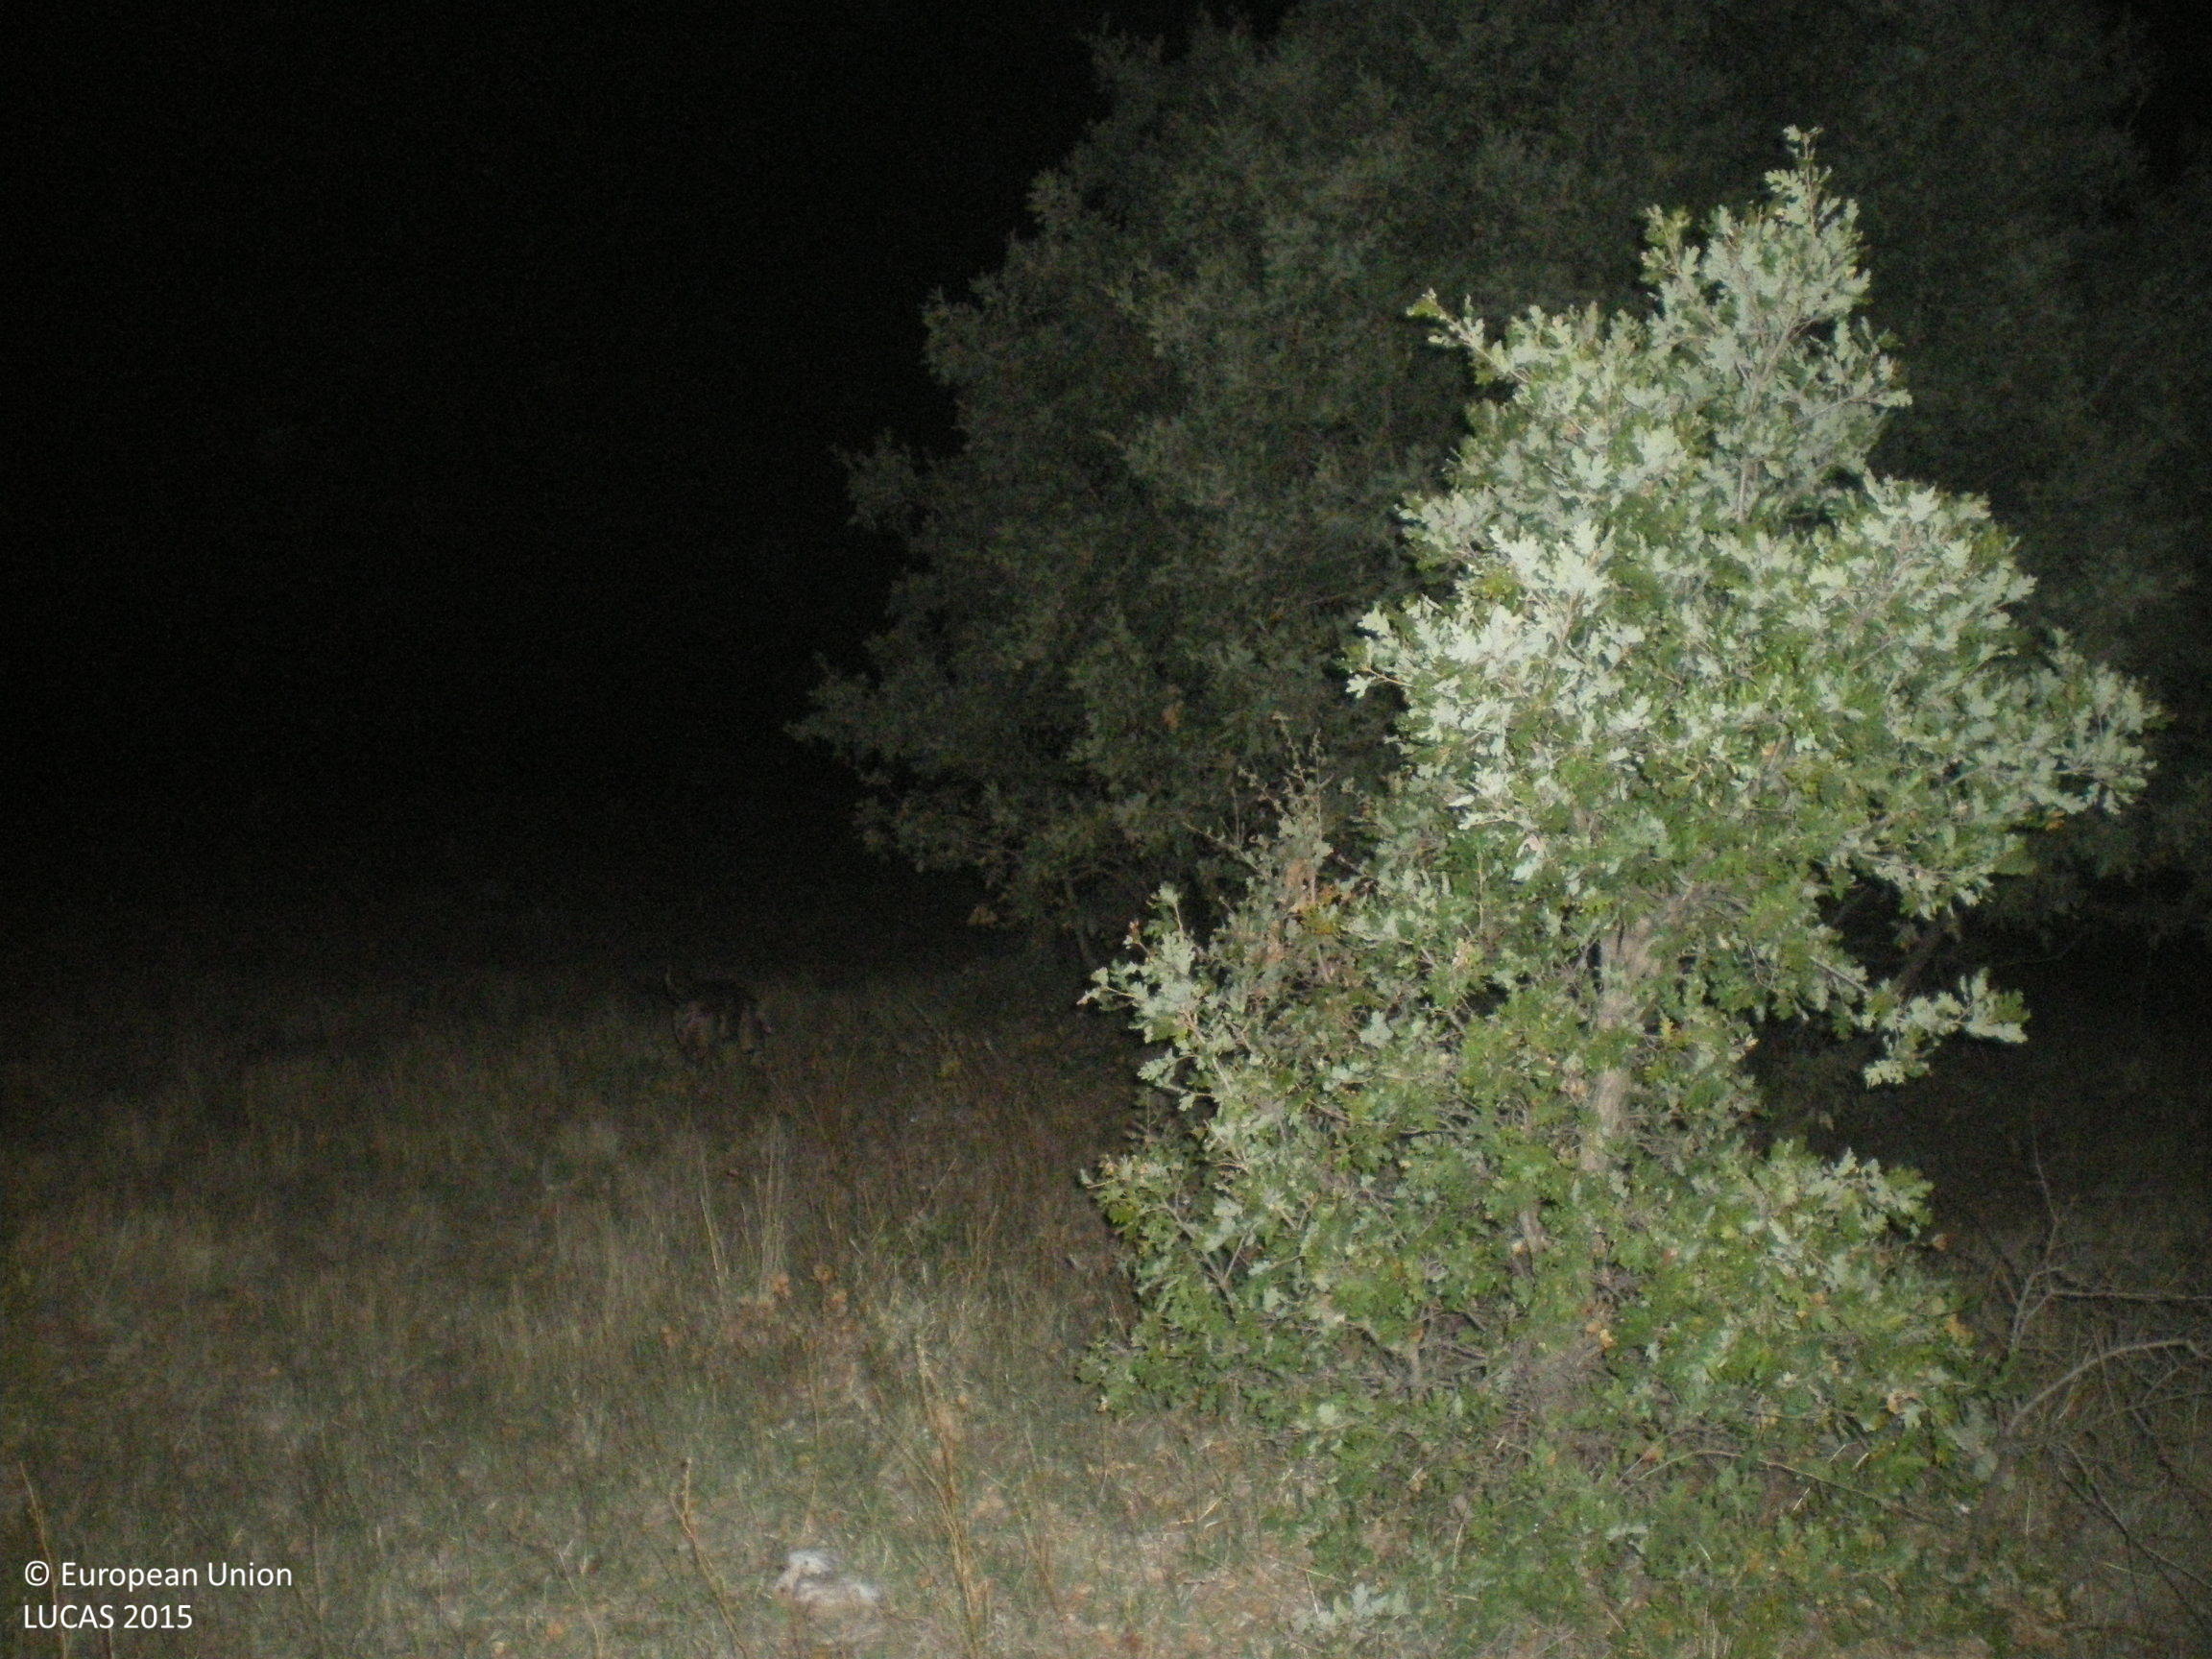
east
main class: Grassland
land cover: Grassland with sparse tree/shrub cover
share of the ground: > 75 %
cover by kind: herbaceous plants 85 %, shrubs 10 %, broadleaved forest trees 5 %
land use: Semi-natural and natural areas not in use
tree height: > 5 m
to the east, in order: Grassland with sparse tree/shrub cover; Broadleaved woodland; Rivers and streams; Broadleaved woodland; Shrubland without tree cover; Grassland with sparse tree/shrub cover; Grassland without tree/shrub cover
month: October
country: BG
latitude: 41.8943
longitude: 26.0687
